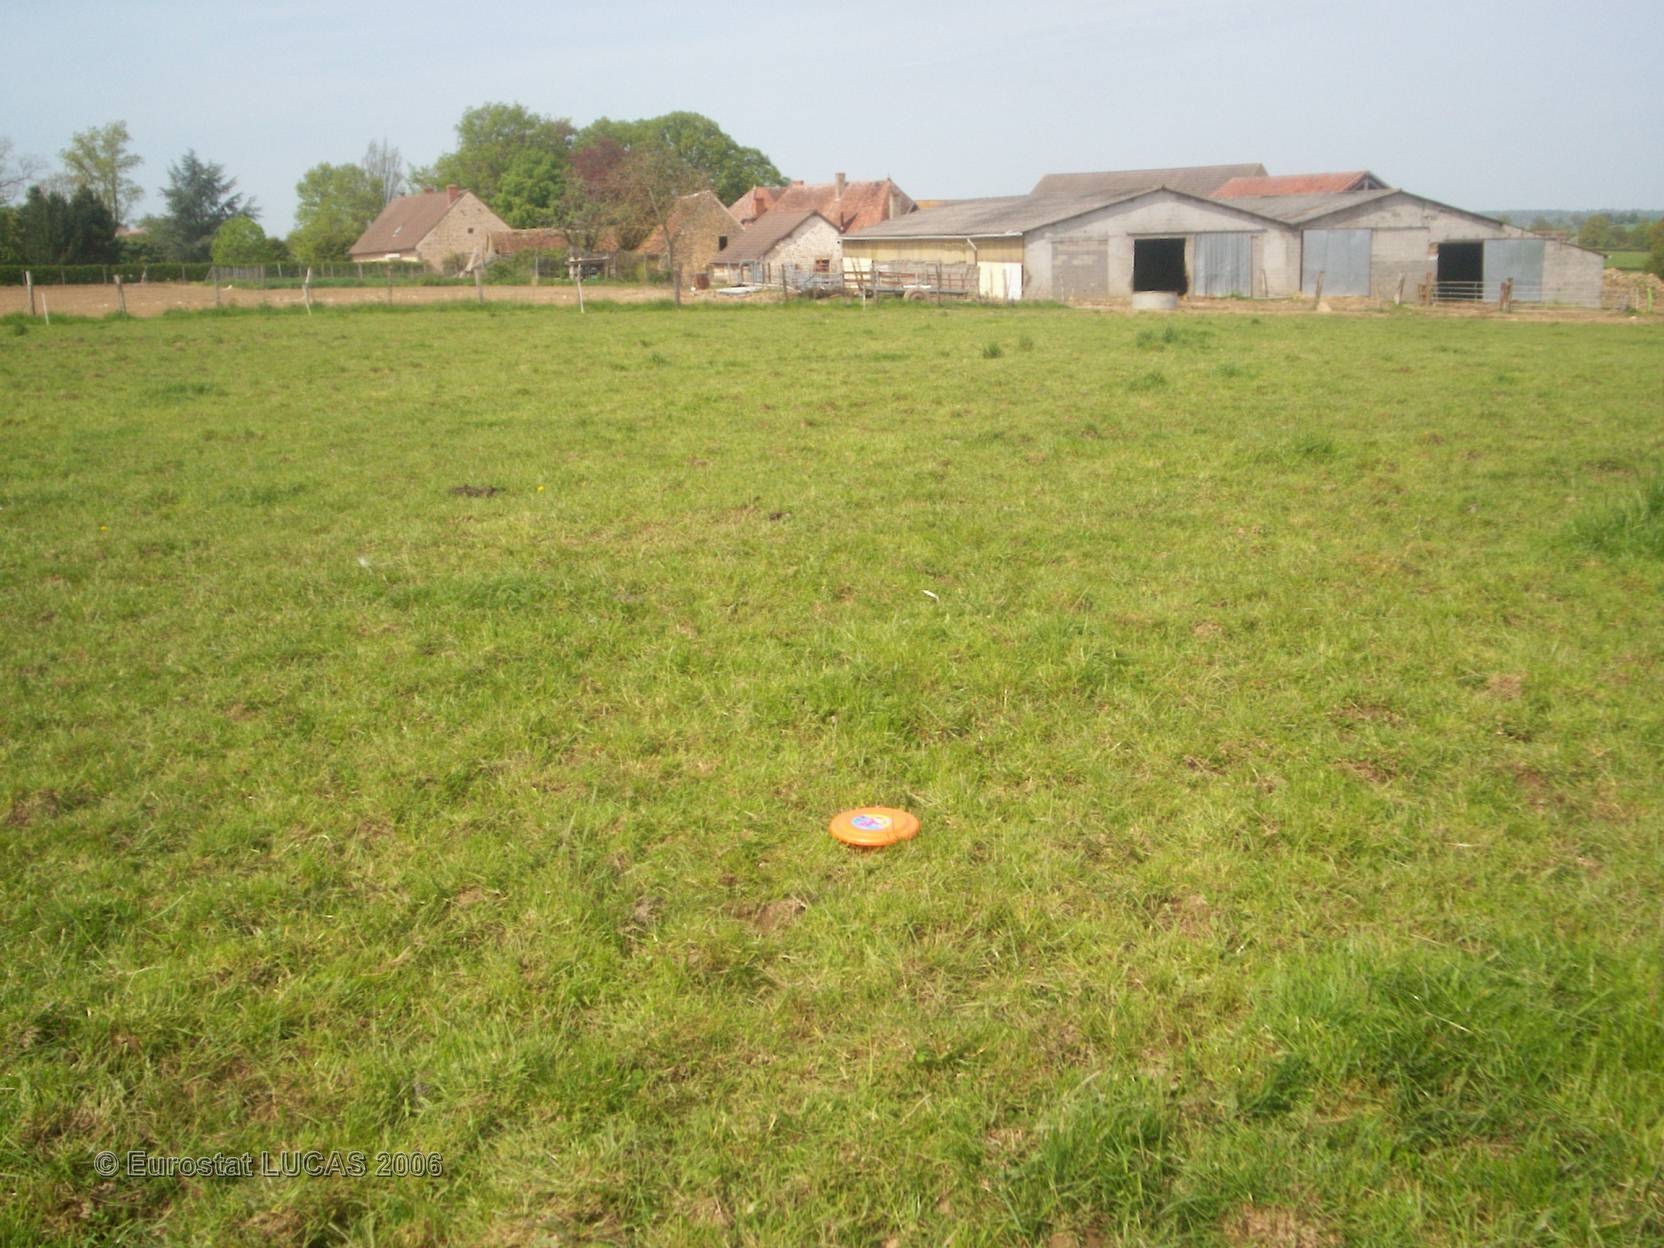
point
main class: Grassland
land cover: Grassland without tree/shrub cover
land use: Agriculture (excluding fallow land and kitchen gardens)
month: May
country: FR
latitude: 46.5601
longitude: 3.0705
